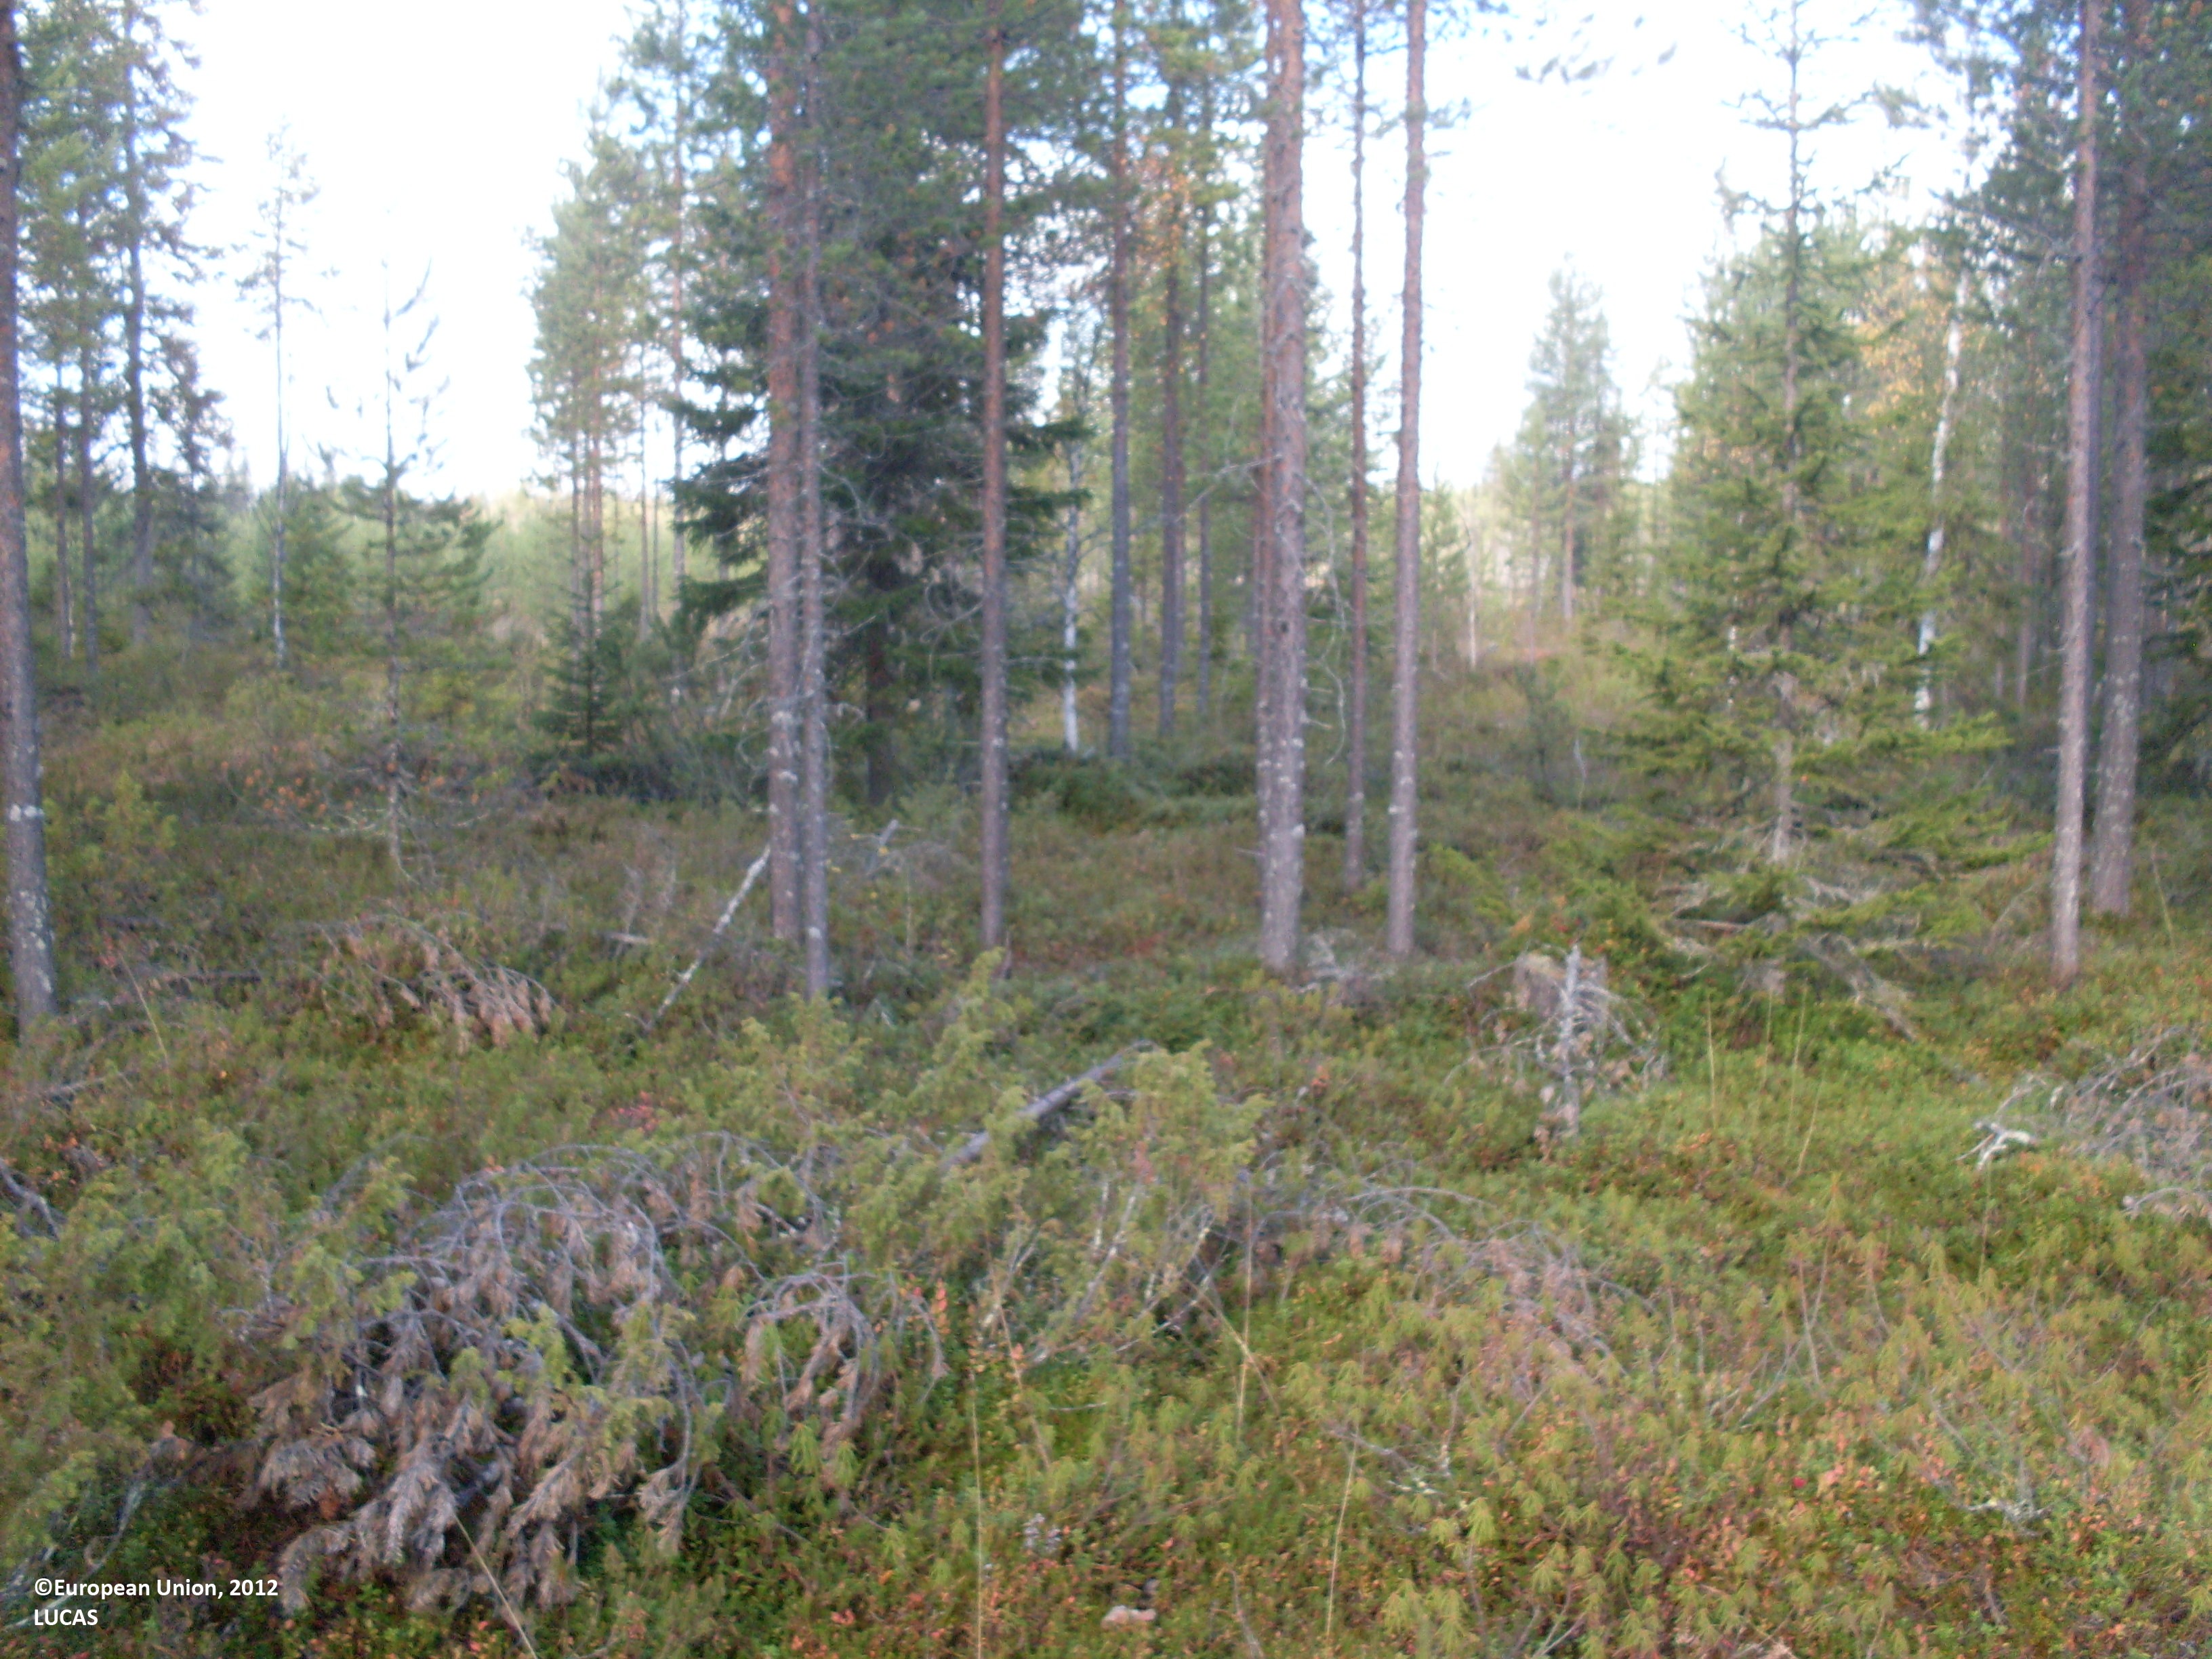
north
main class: Woodland
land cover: Pine dominated mixed woodland
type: boreal forest
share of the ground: 10 - 25 %
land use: Forestry
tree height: > 5 m
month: September
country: FI
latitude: 64.7512
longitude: 29.4326
